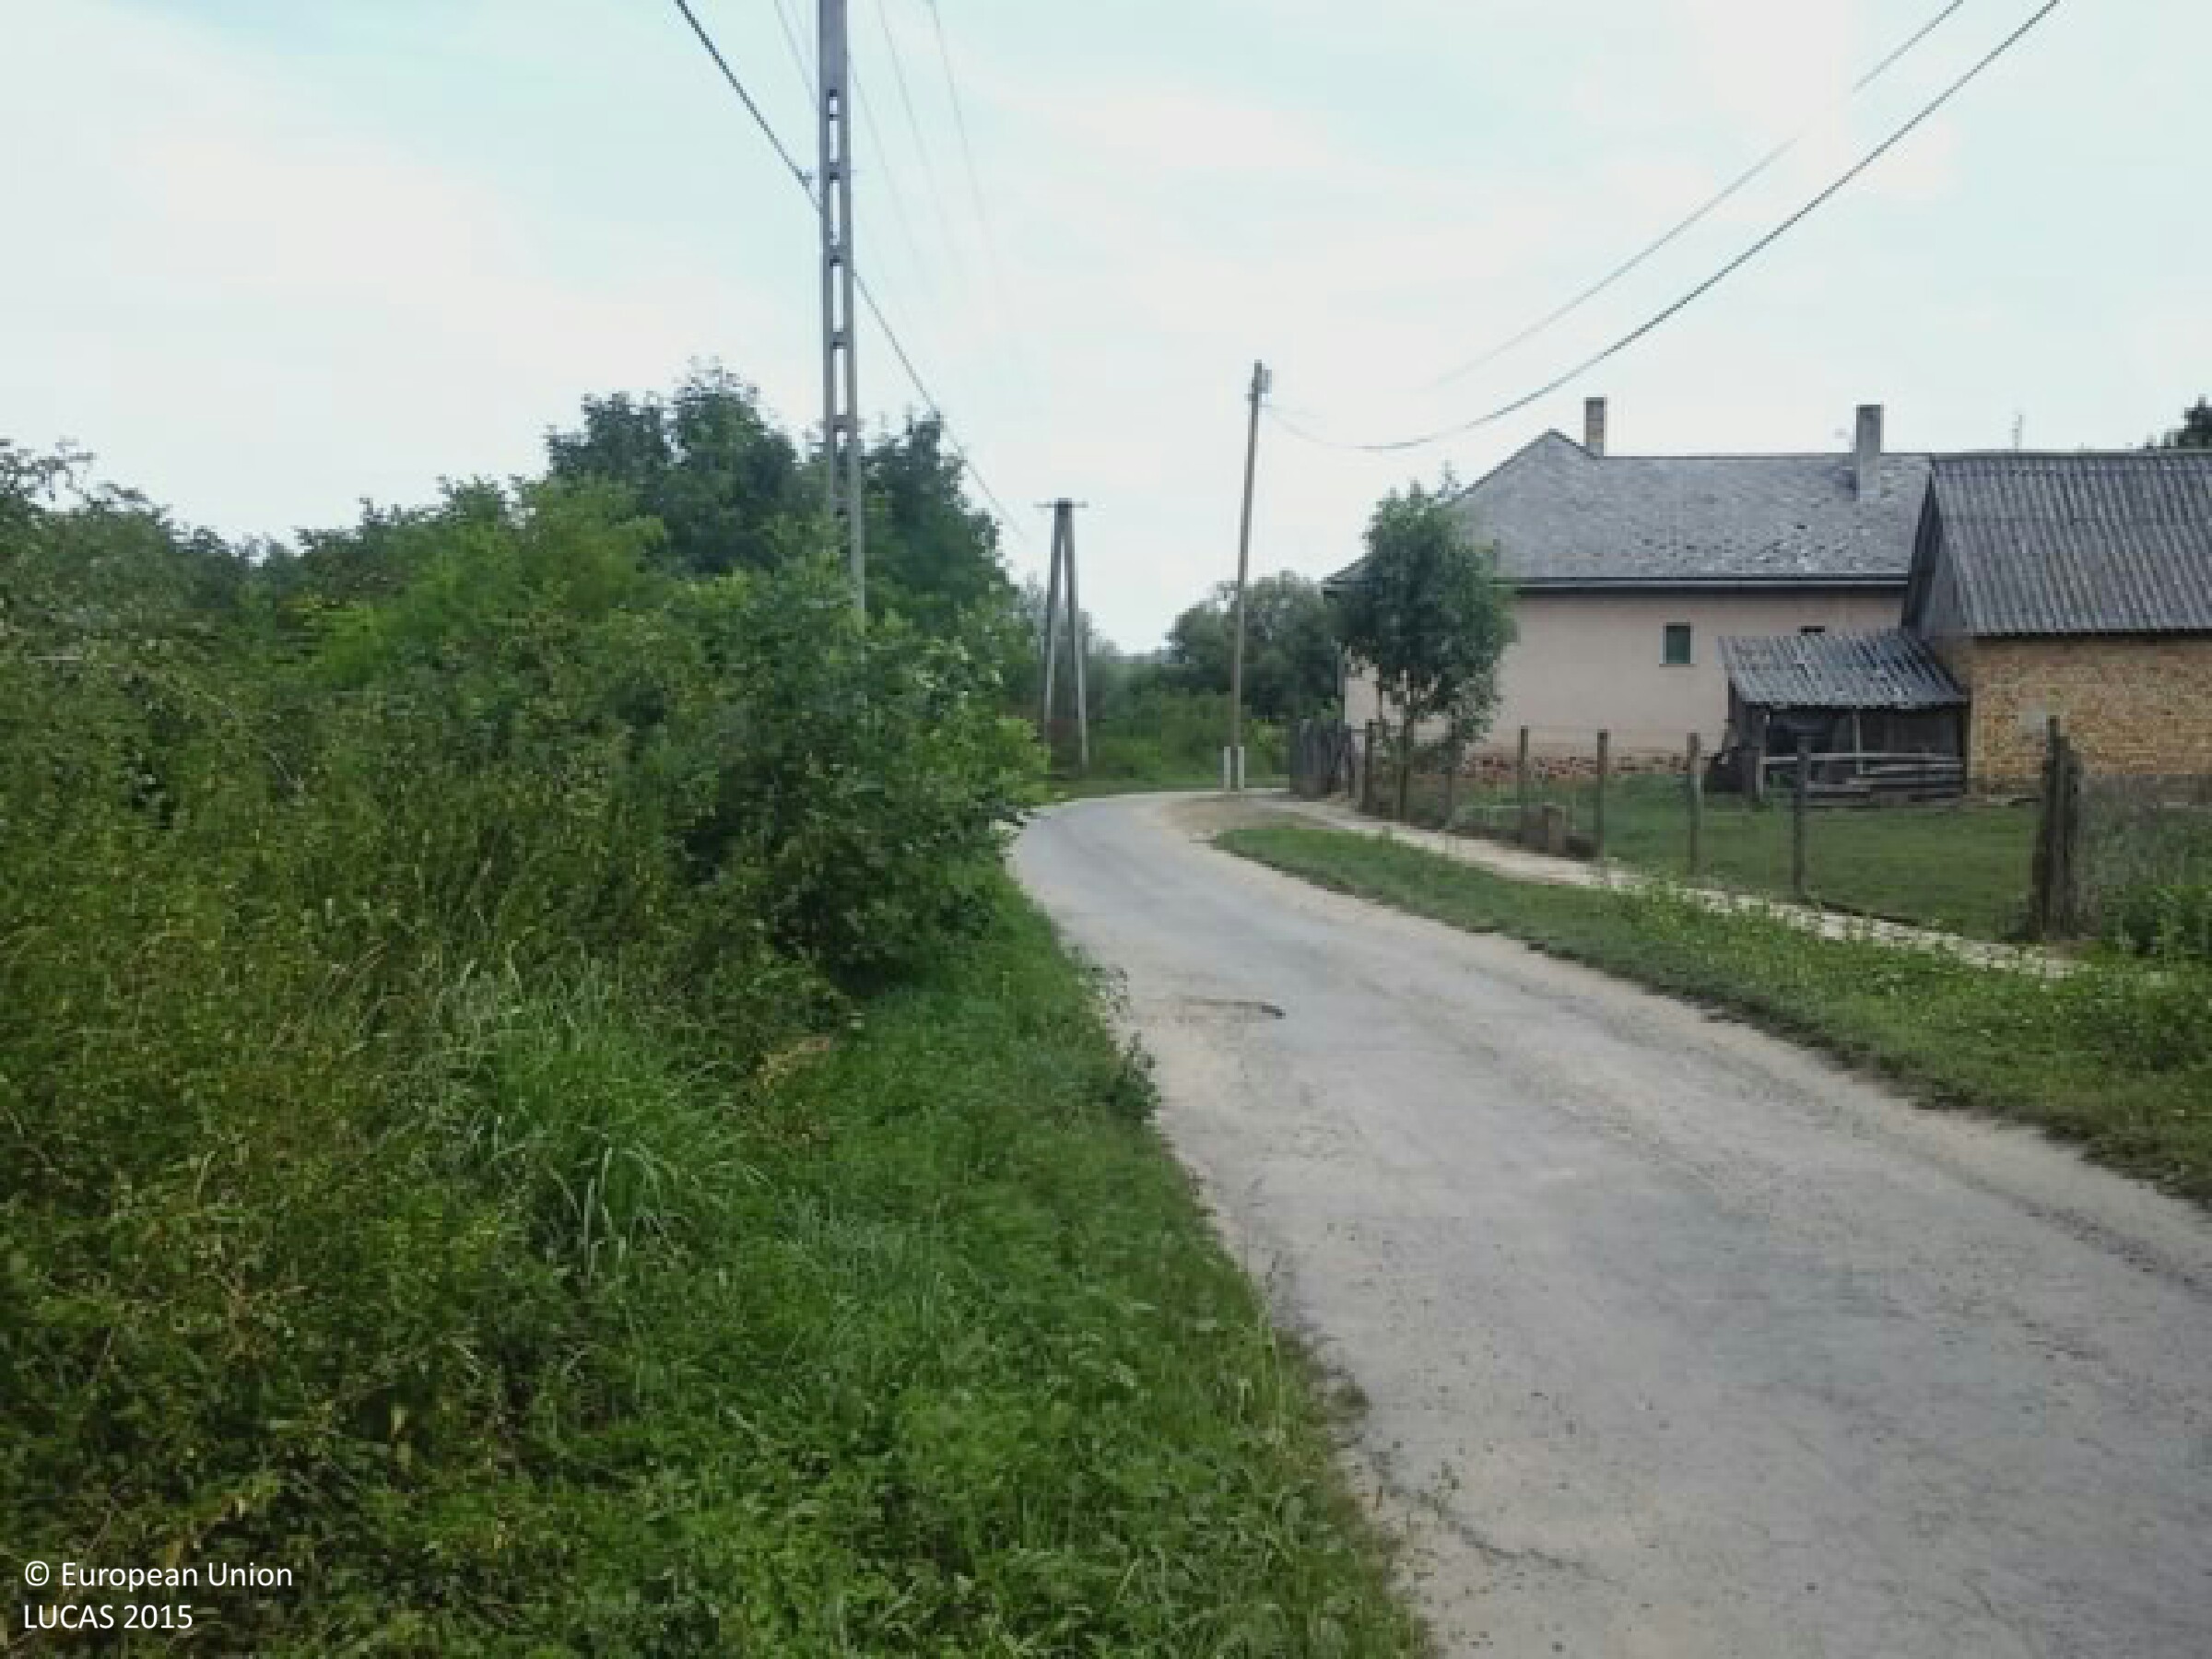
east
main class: Shrubland
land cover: Shrubland without tree cover
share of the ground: > 75 %
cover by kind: shrubs 60 %, herbaceous plants 40 %
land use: Fallow land
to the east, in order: Shrubland without tree cover; Inland marshes
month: August
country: HU
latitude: 46.5260
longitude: 18.1824
